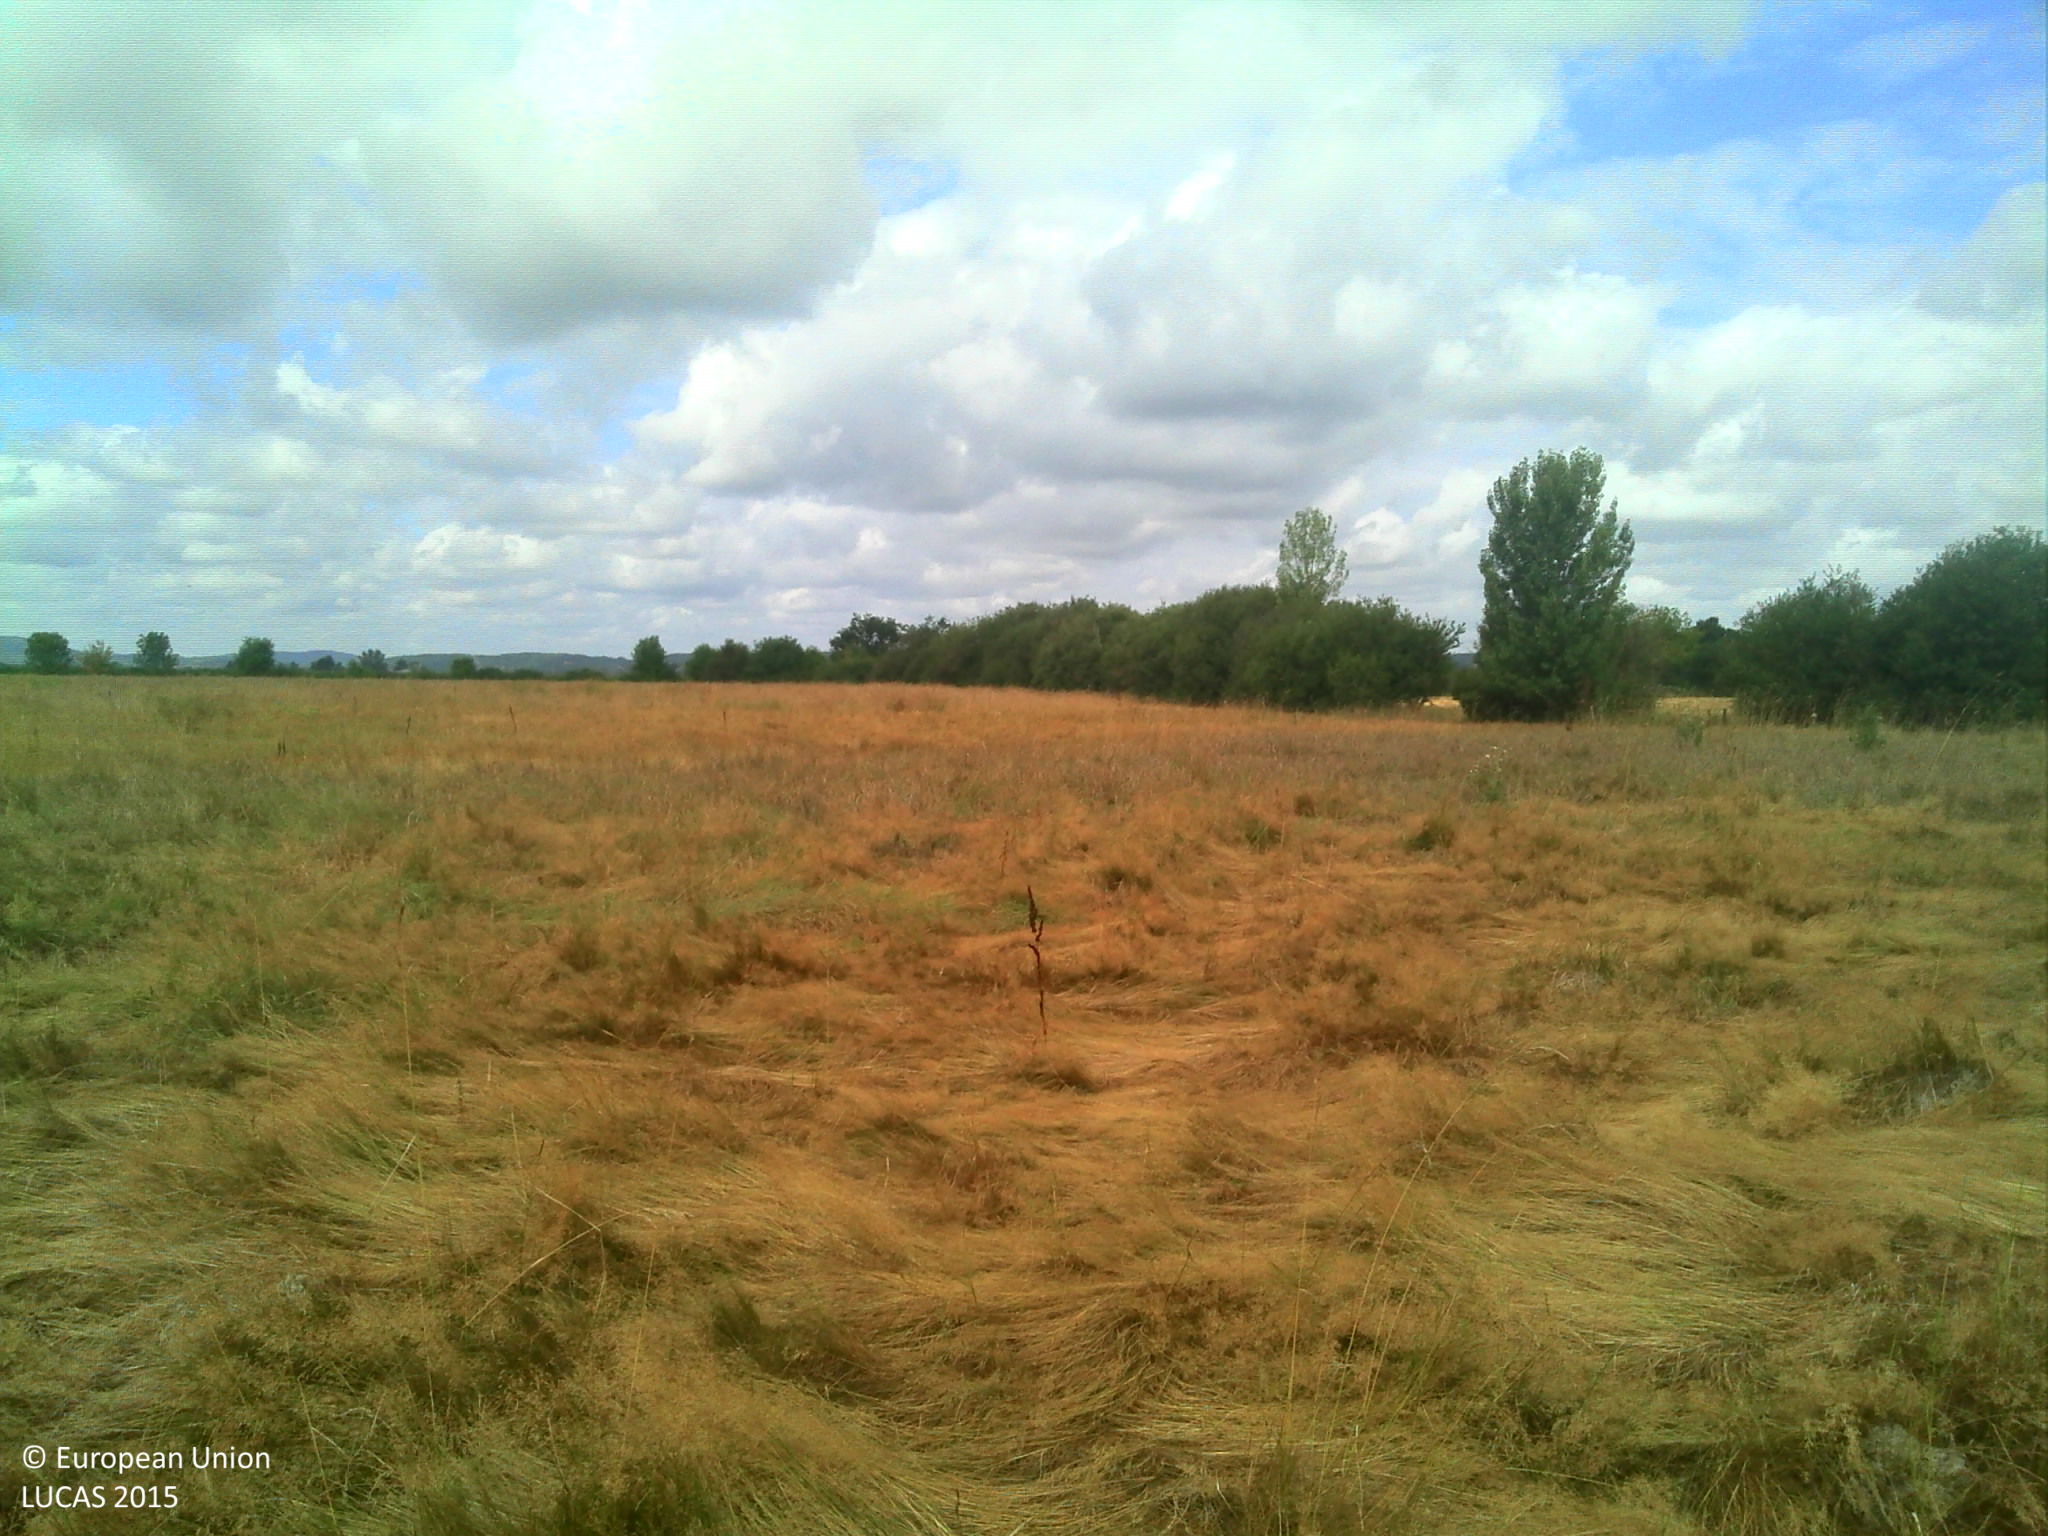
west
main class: Grassland
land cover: Grassland without tree/shrub cover
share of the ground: > 75 %
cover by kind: herbaceous plants 100 %
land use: Agriculture (excluding fallow land and kitchen gardens)
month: July
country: FR
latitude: 43.2418
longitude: 1.0992
